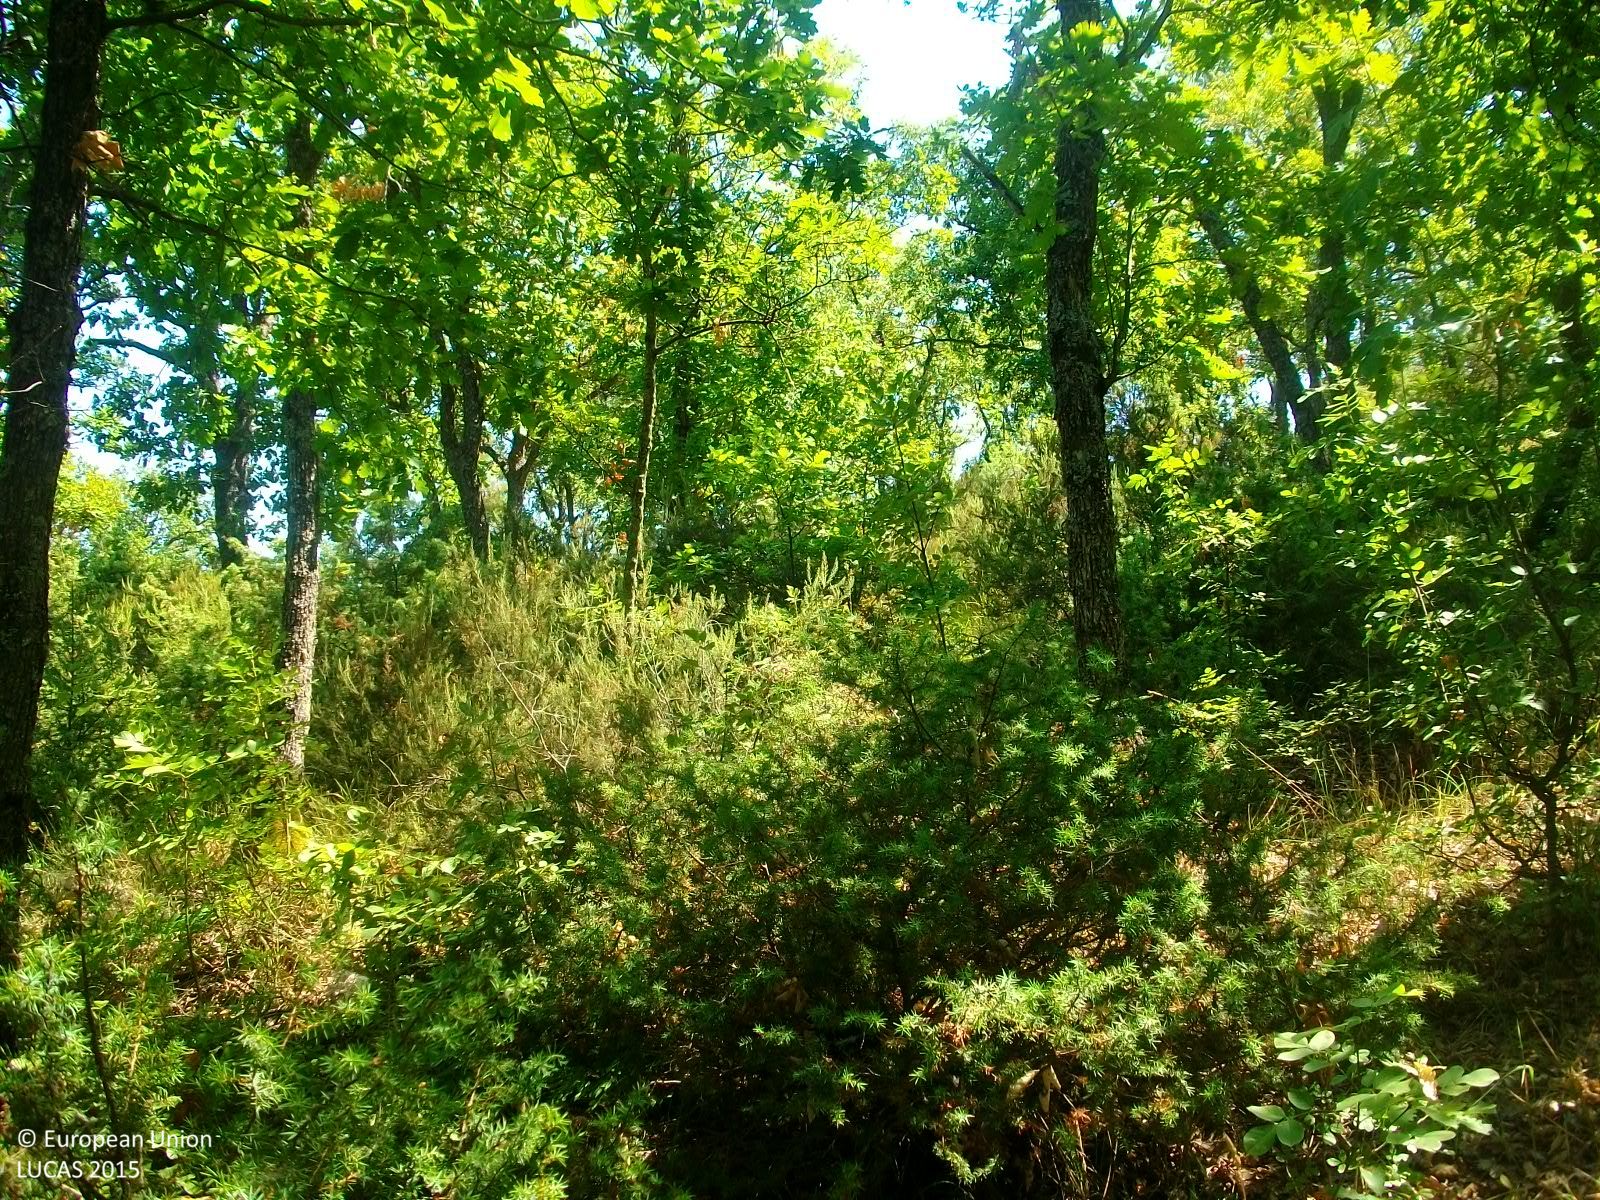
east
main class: Woodland
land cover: Broadleaved woodland
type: thermophilous deciduous forest
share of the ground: > 75 %
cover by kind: broadleaved forest trees 90 %, shrubs 5 %, herbaceous plants 5 %
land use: Forestry
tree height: > 5 m
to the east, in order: Broadleaved woodland; Tracks; Broadleaved woodland
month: August
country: GR
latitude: 41.2554
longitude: 26.2654
